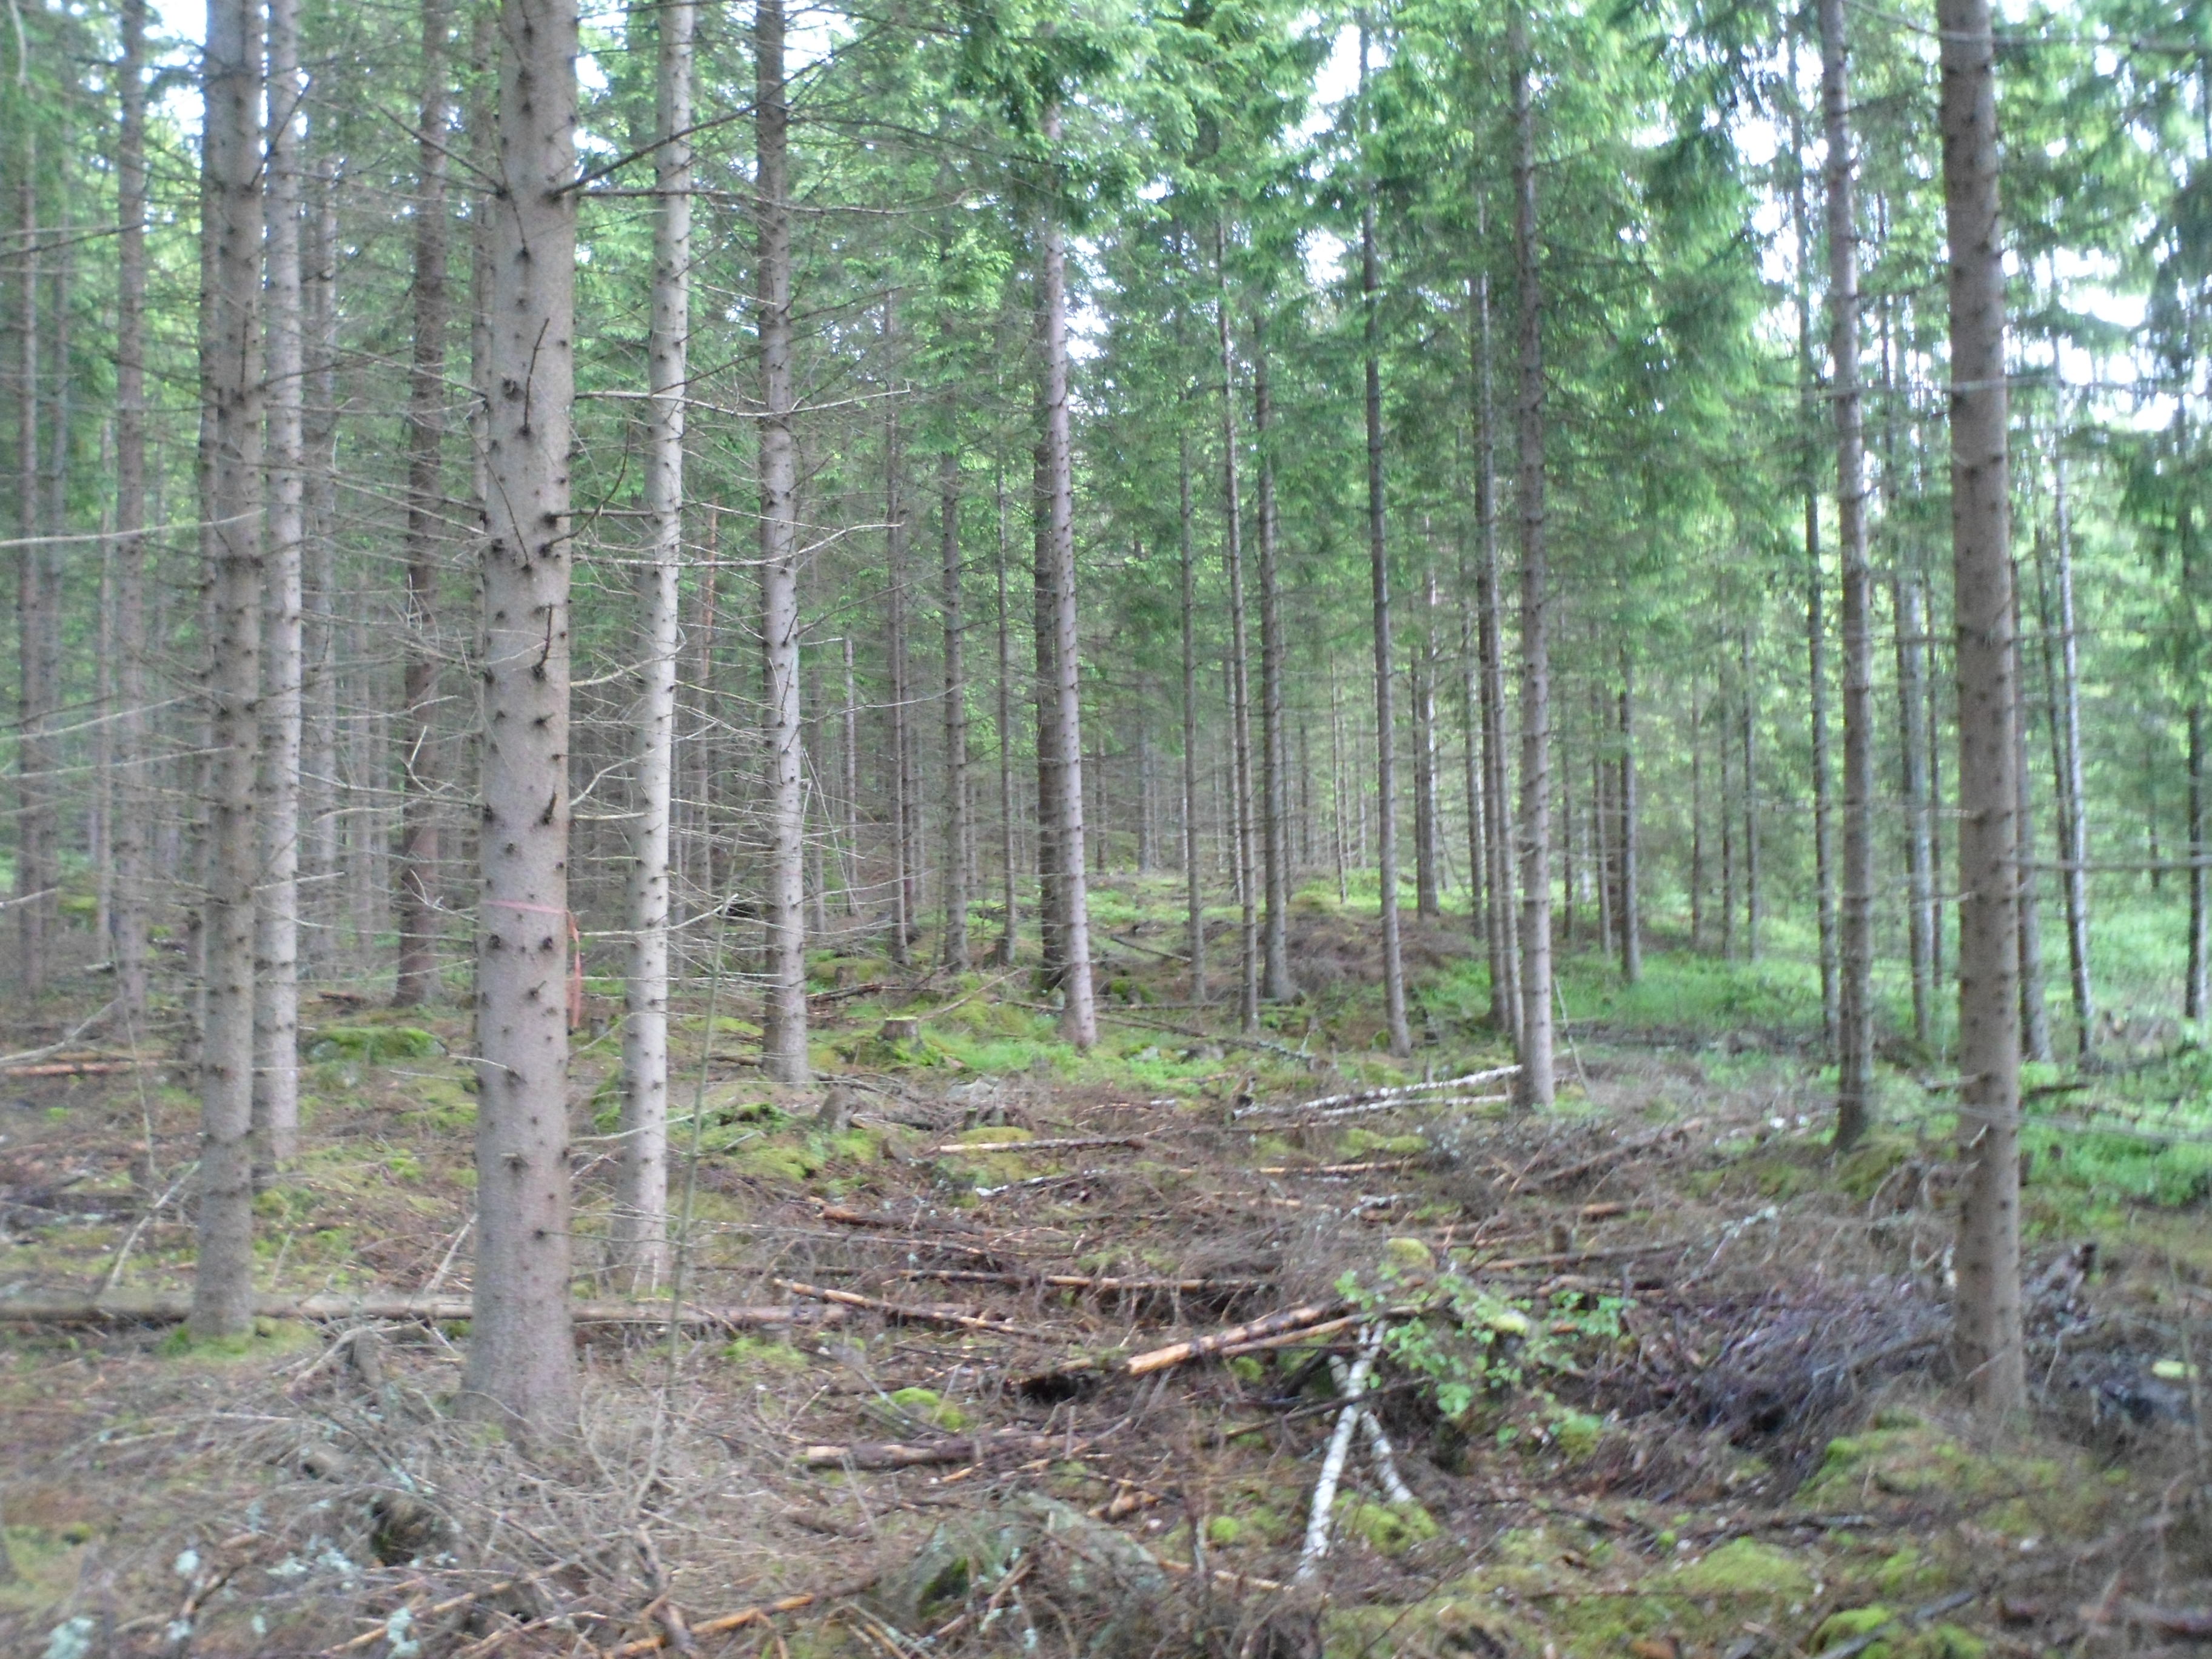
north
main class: Woodland
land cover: Spruce dominated coniferous woodland
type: boreal forest
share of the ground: > 75 %
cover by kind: coniferous forest trees 75 %, lichens and mosses 15 %, unconsolidated bare surface 10 %
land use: Forestry
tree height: > 5 m
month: June
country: SE
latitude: 56.8896
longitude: 14.3136
